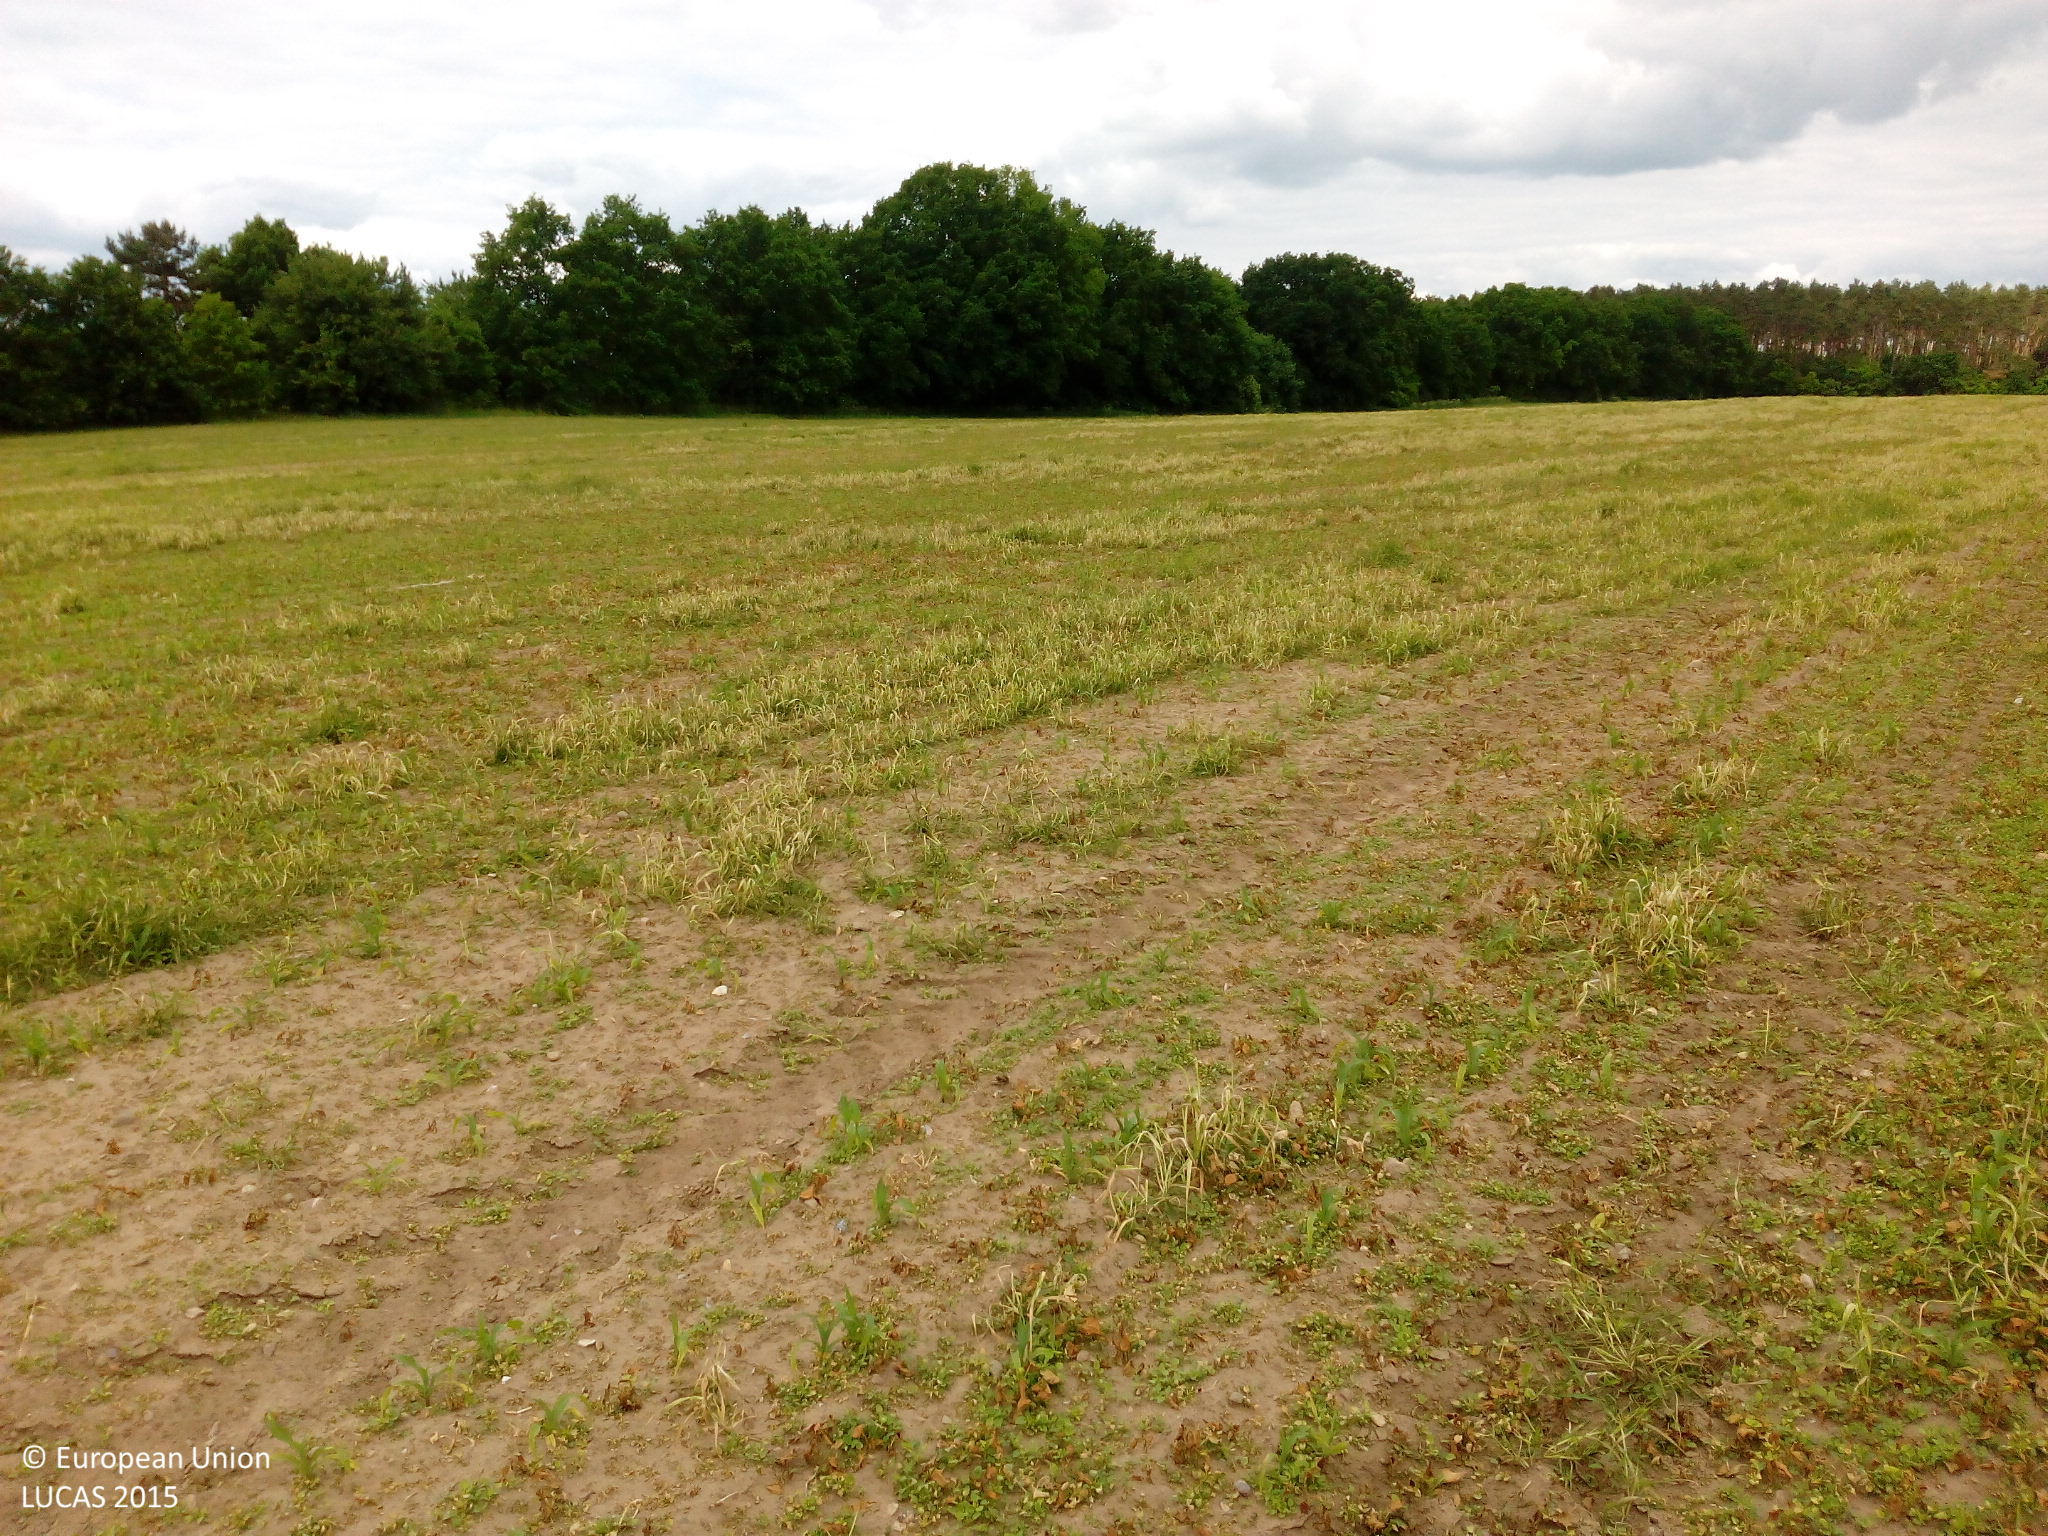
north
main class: Cropland
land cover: Maize
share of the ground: < 10 %
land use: Agriculture (excluding fallow land and kitchen gardens)
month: June
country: DE
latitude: 53.3969
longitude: 12.3604
